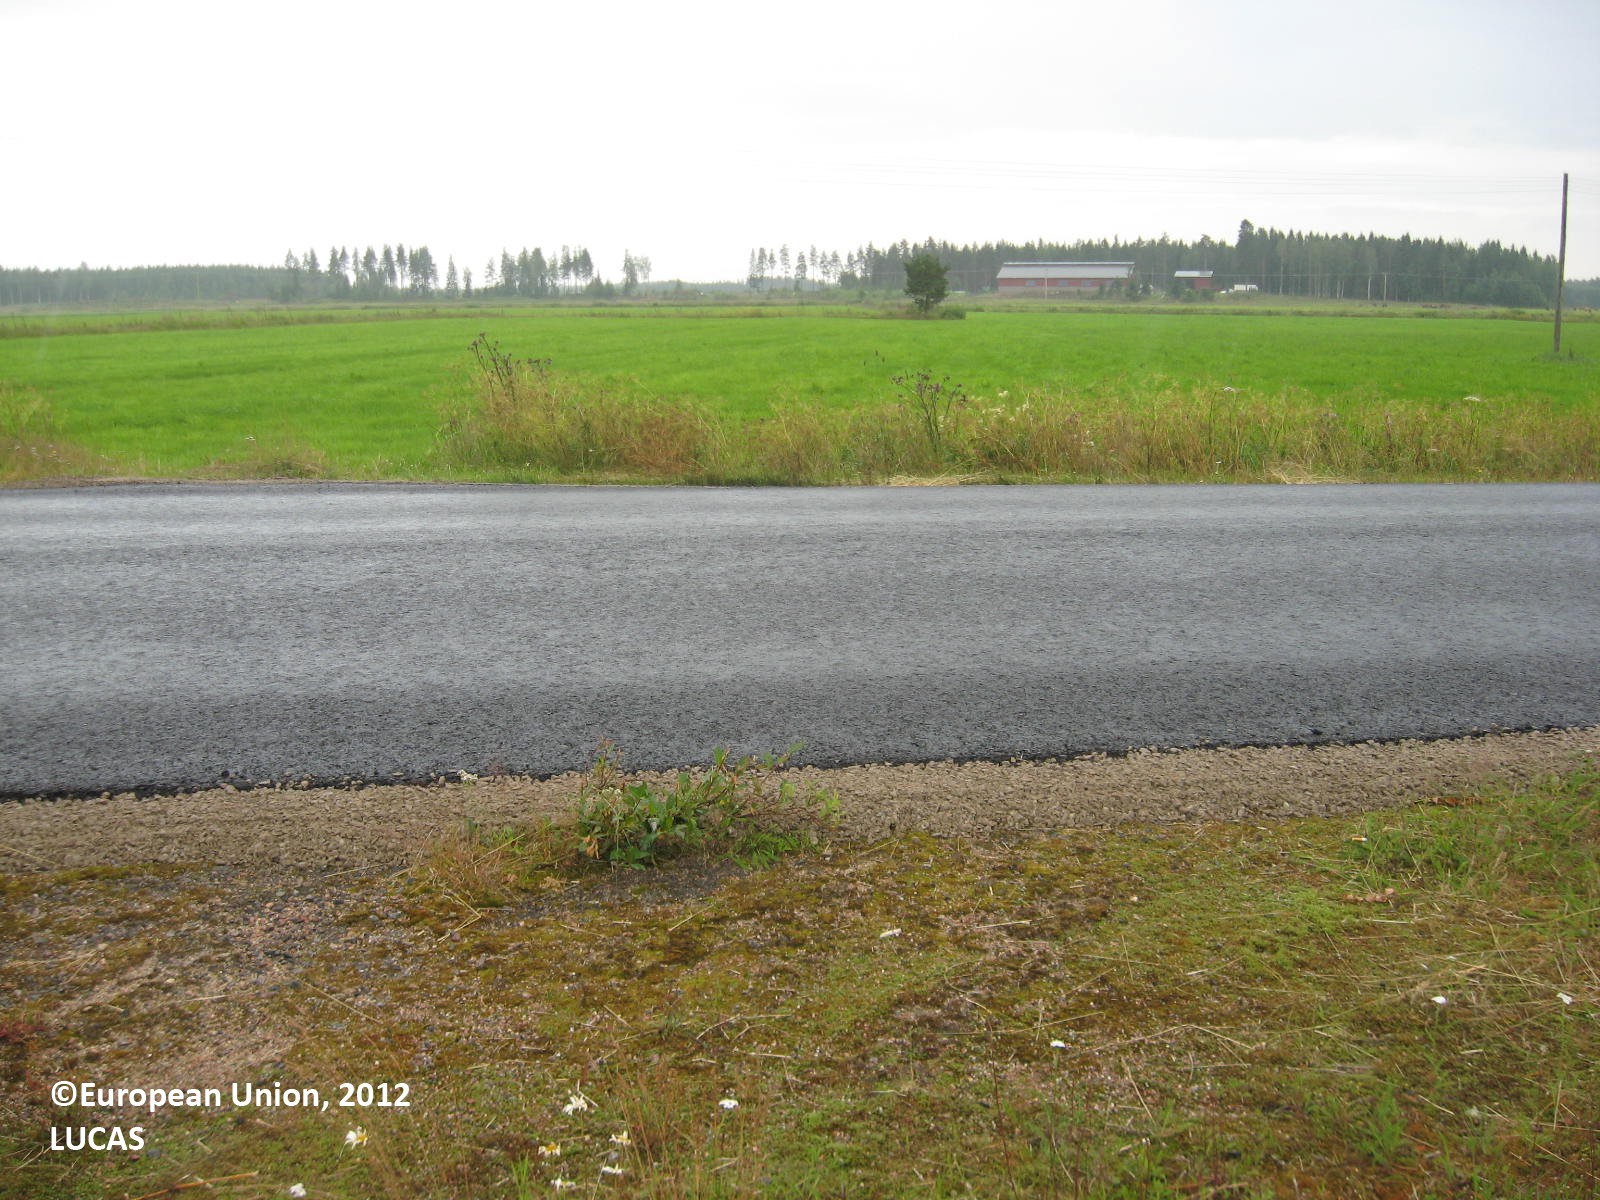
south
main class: Grassland
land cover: Grassland without tree/shrub cover
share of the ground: > 75 %
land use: Agriculture (excluding fallow land and kitchen gardens)
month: July
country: FI
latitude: 62.1834
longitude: 22.6814
